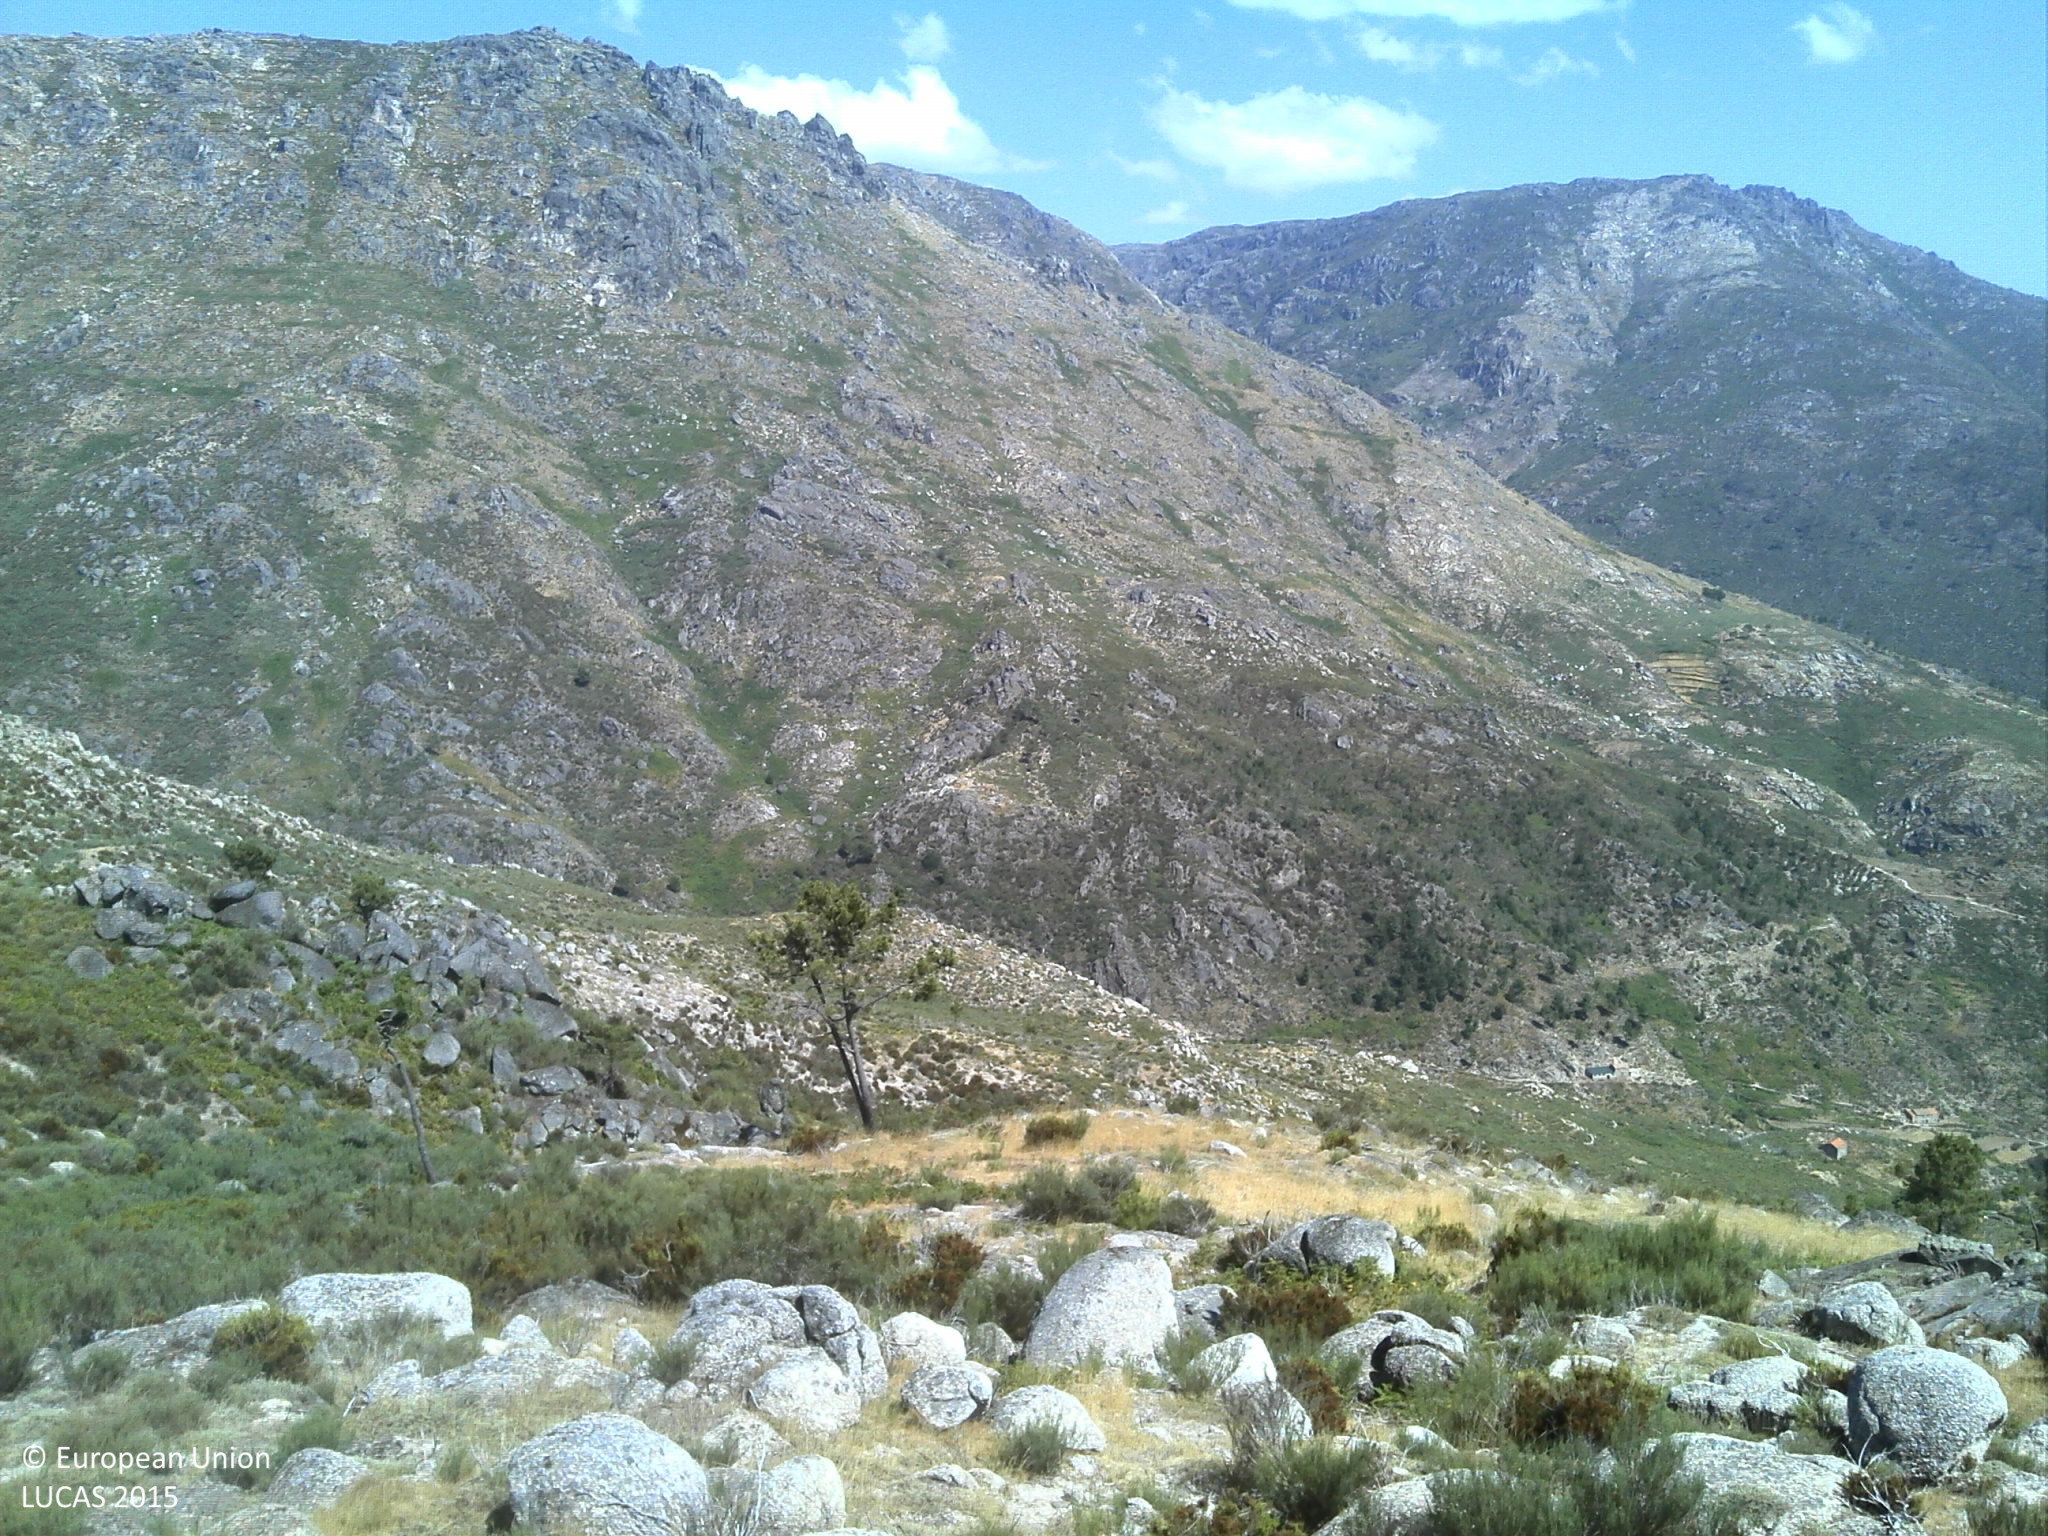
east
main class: Shrubland
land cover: Shrubland without tree cover
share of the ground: 50 - 75 %
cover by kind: shrubs 60 %, unconsolidated bare surface 30 %, herbaceous plants 10 %
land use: Semi-natural and natural areas not in use
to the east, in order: Shrubland without tree cover; Rivers and streams; Rocks and stones
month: July
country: PT
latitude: 40.3442
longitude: -7.6896
